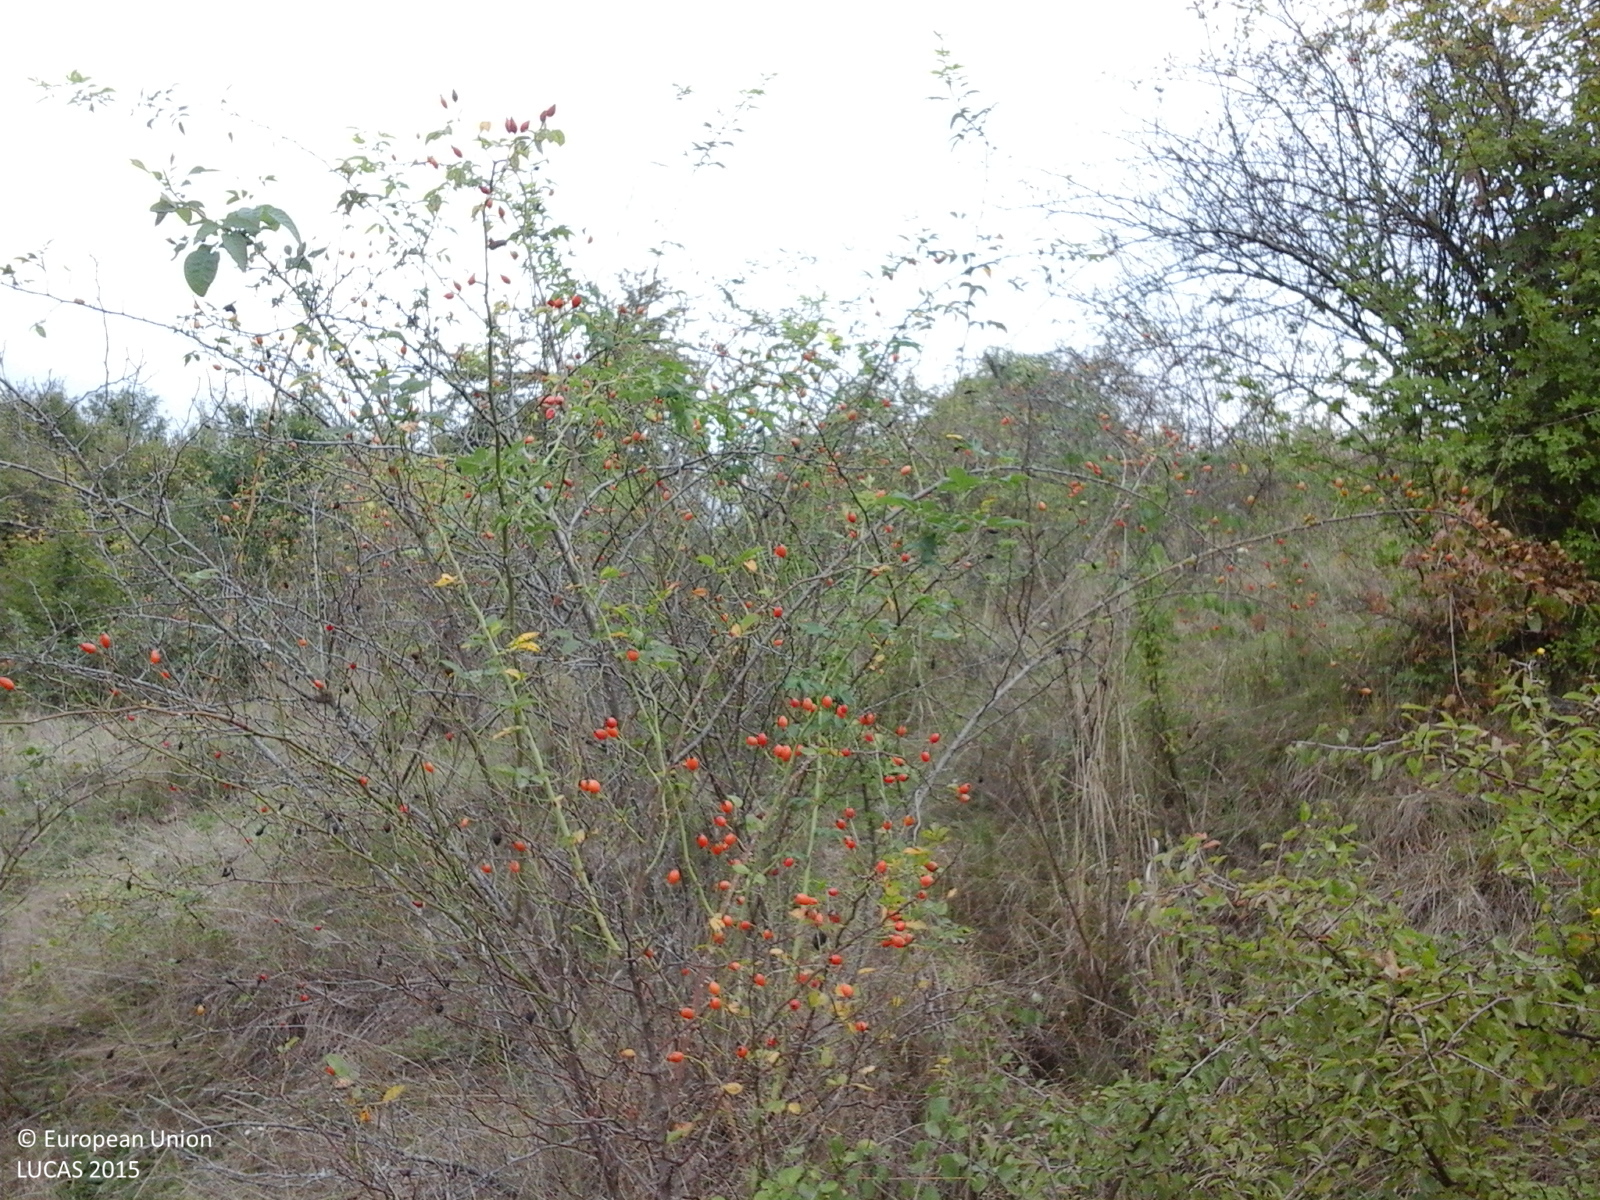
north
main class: Shrubland
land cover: Shrubland with sparse tree cover
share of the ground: > 75 %
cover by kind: herbaceous plants 55 %, shrubs 40 %, broadleaved forest trees 5 %
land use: Fallow land
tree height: < 5 m
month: September
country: RO
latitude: 45.9254
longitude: 22.0209
